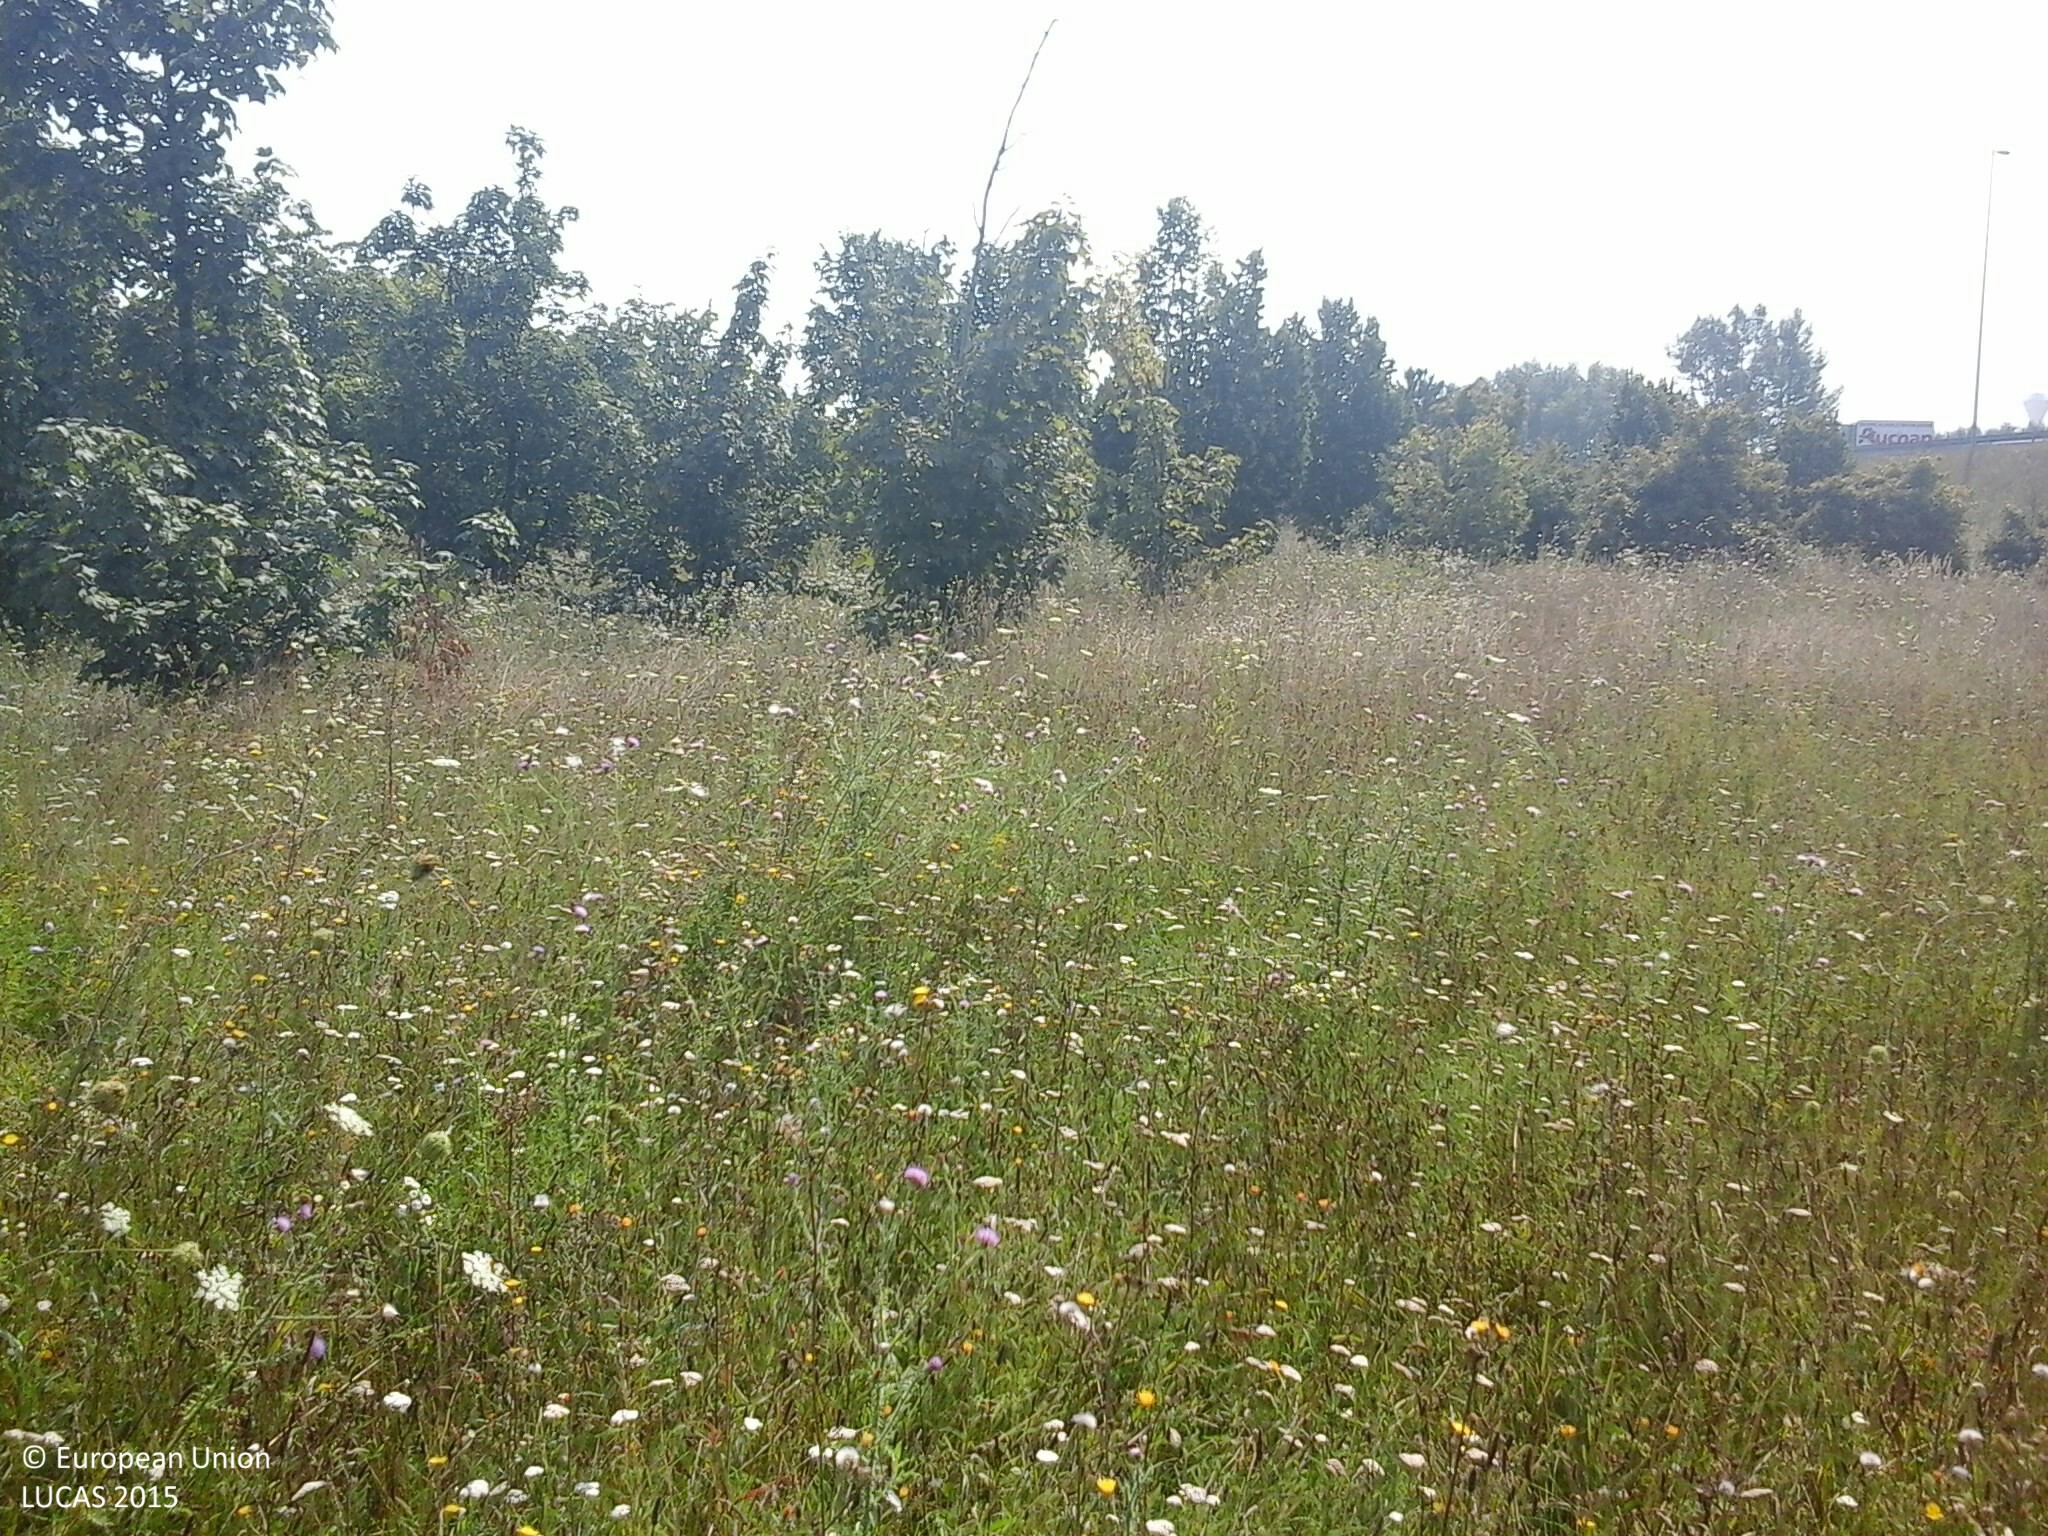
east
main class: Grassland
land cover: Grassland without tree/shrub cover
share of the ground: > 75 %
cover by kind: herbaceous plants 100 %
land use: Road transport
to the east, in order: Grassland without tree/shrub cover; Broadleaved woodland; Spontaneously vegetated surfaces; Paved roads, cycling and walking lanes; Grass margins; Paved roads, cycling and walking lanes; Grassland with sparse tree/shrub cover; Ditches and canals; Tracks; Spontaneously vegetated surfaces; Fences; Grassland with sparse tree/shrub cover
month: August
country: HU
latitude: 47.4256
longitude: 19.1521
